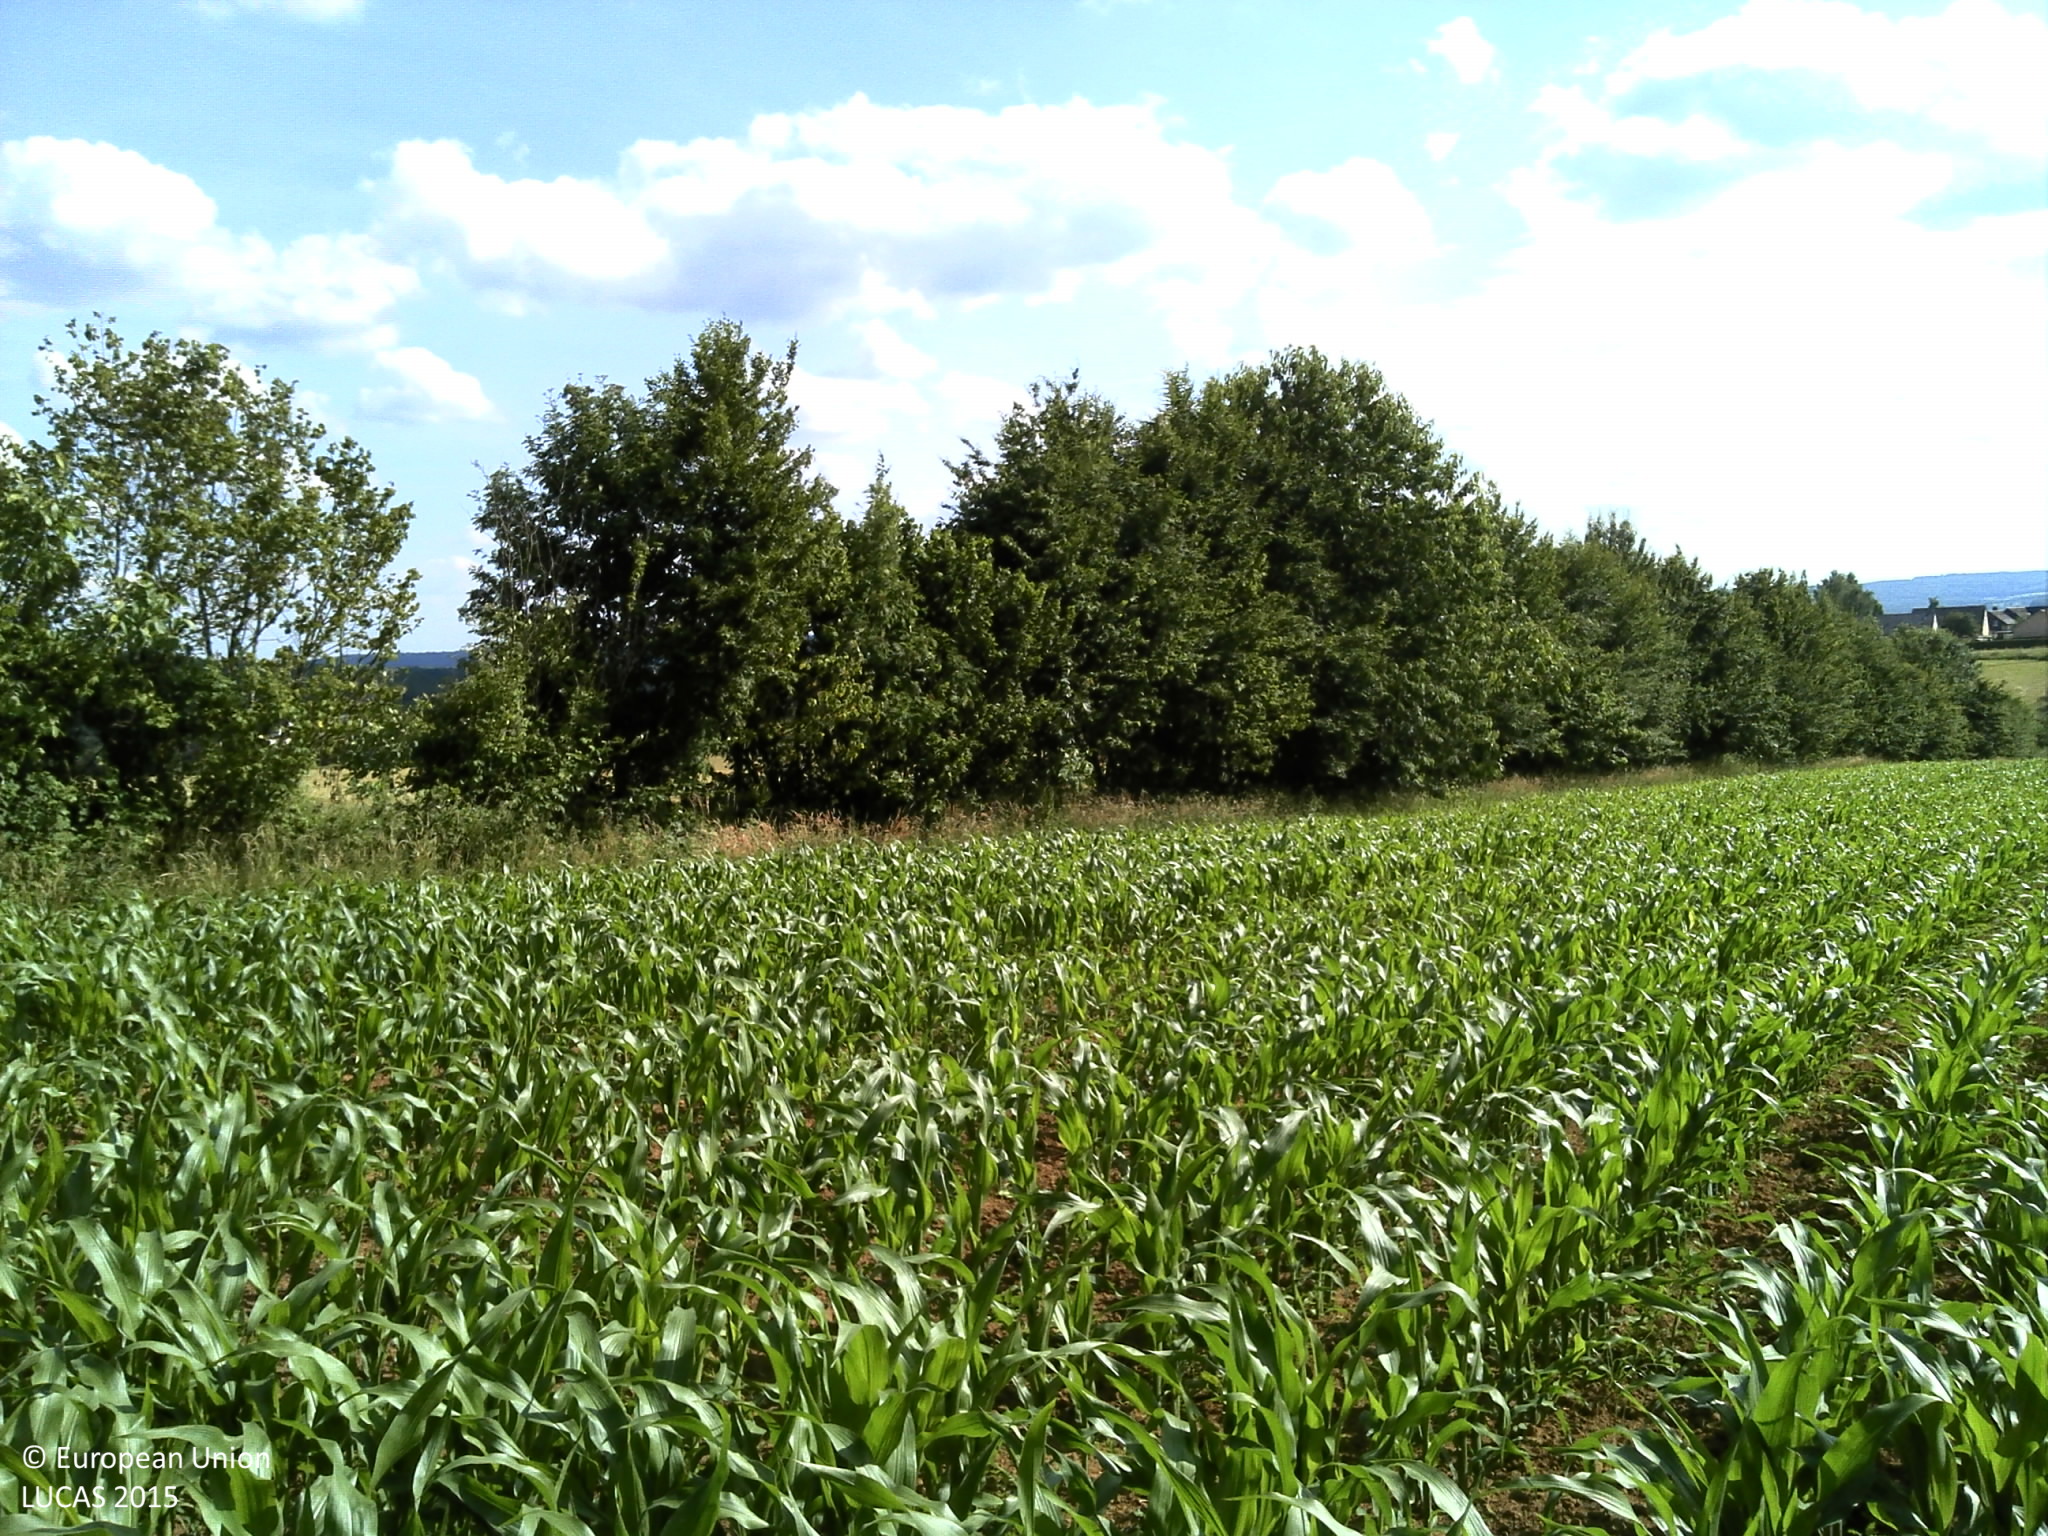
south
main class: Cropland
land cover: Maize
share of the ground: 25 - 50 %
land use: Agriculture (excluding fallow land and kitchen gardens)
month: June
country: FR
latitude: 49.7589
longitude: 4.7913
